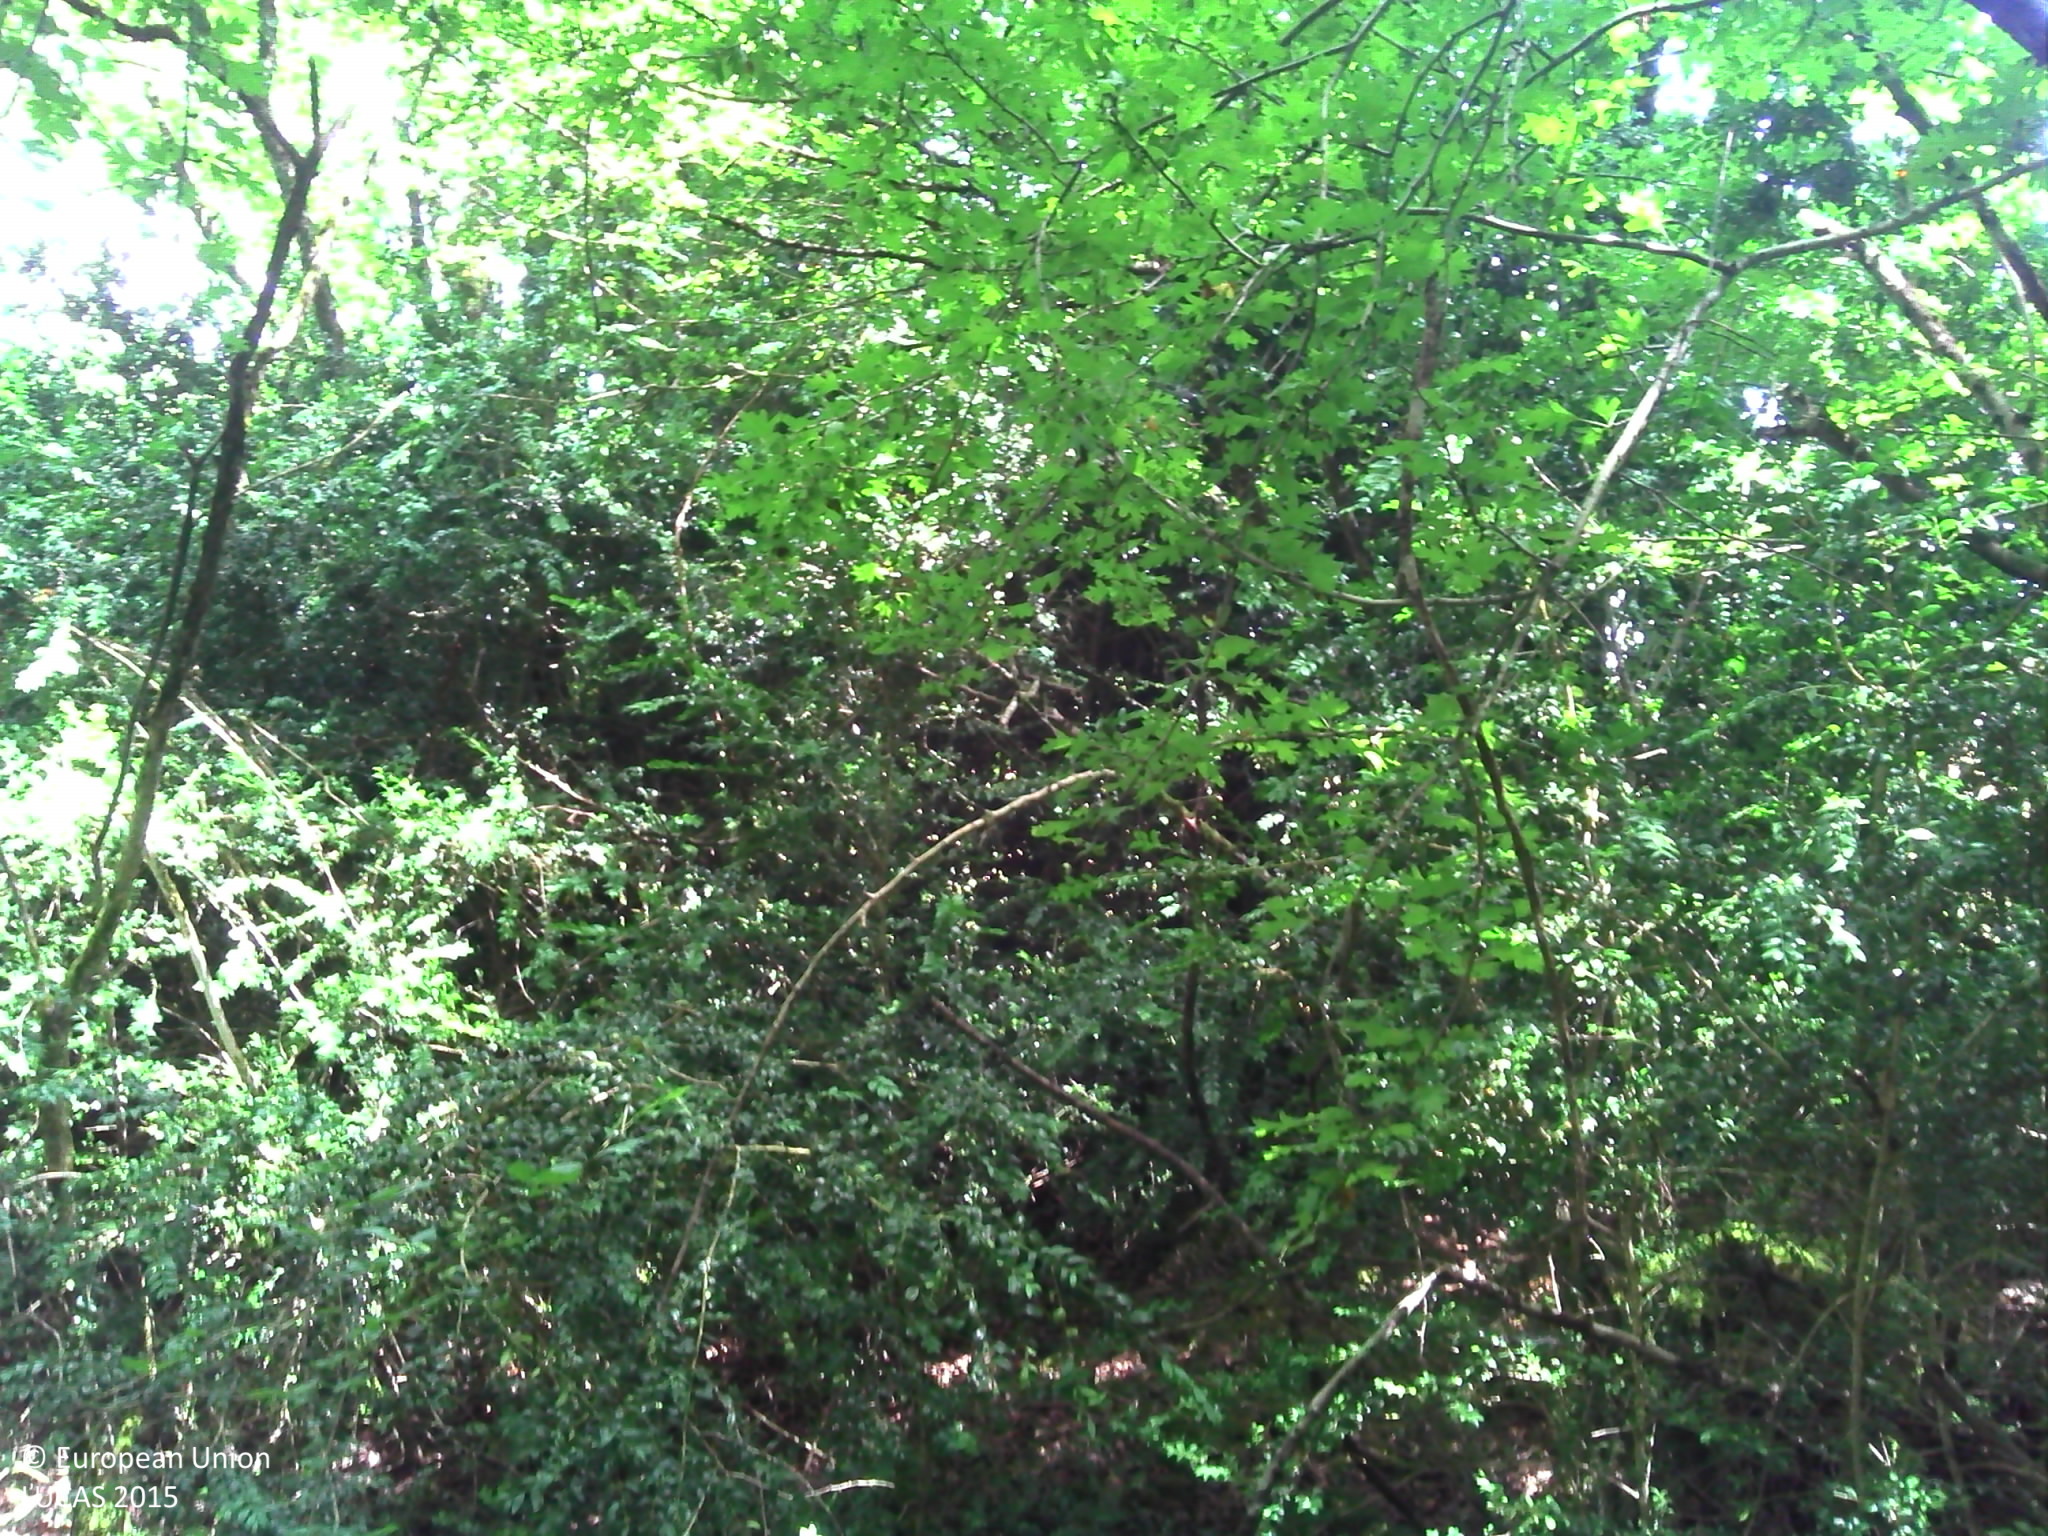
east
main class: Woodland
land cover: Broadleaved woodland
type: thermophilous deciduous forest
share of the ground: > 75 %
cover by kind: broadleaved forest trees 85 %, herbaceous plants 10 %, shrubs 5 %
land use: Forestry
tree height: > 5 m
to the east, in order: Broadleaved woodland; Rape and turnip rape; Fences; Grassland without tree/shrub cover; Fences; Shruby margins; Ditches and canals; Grass margins; Paved roads, cycling and walking lanes; Grass margins; Fences; Broadleaved woodland
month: June
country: FR
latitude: 45.7156
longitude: 0.3627
